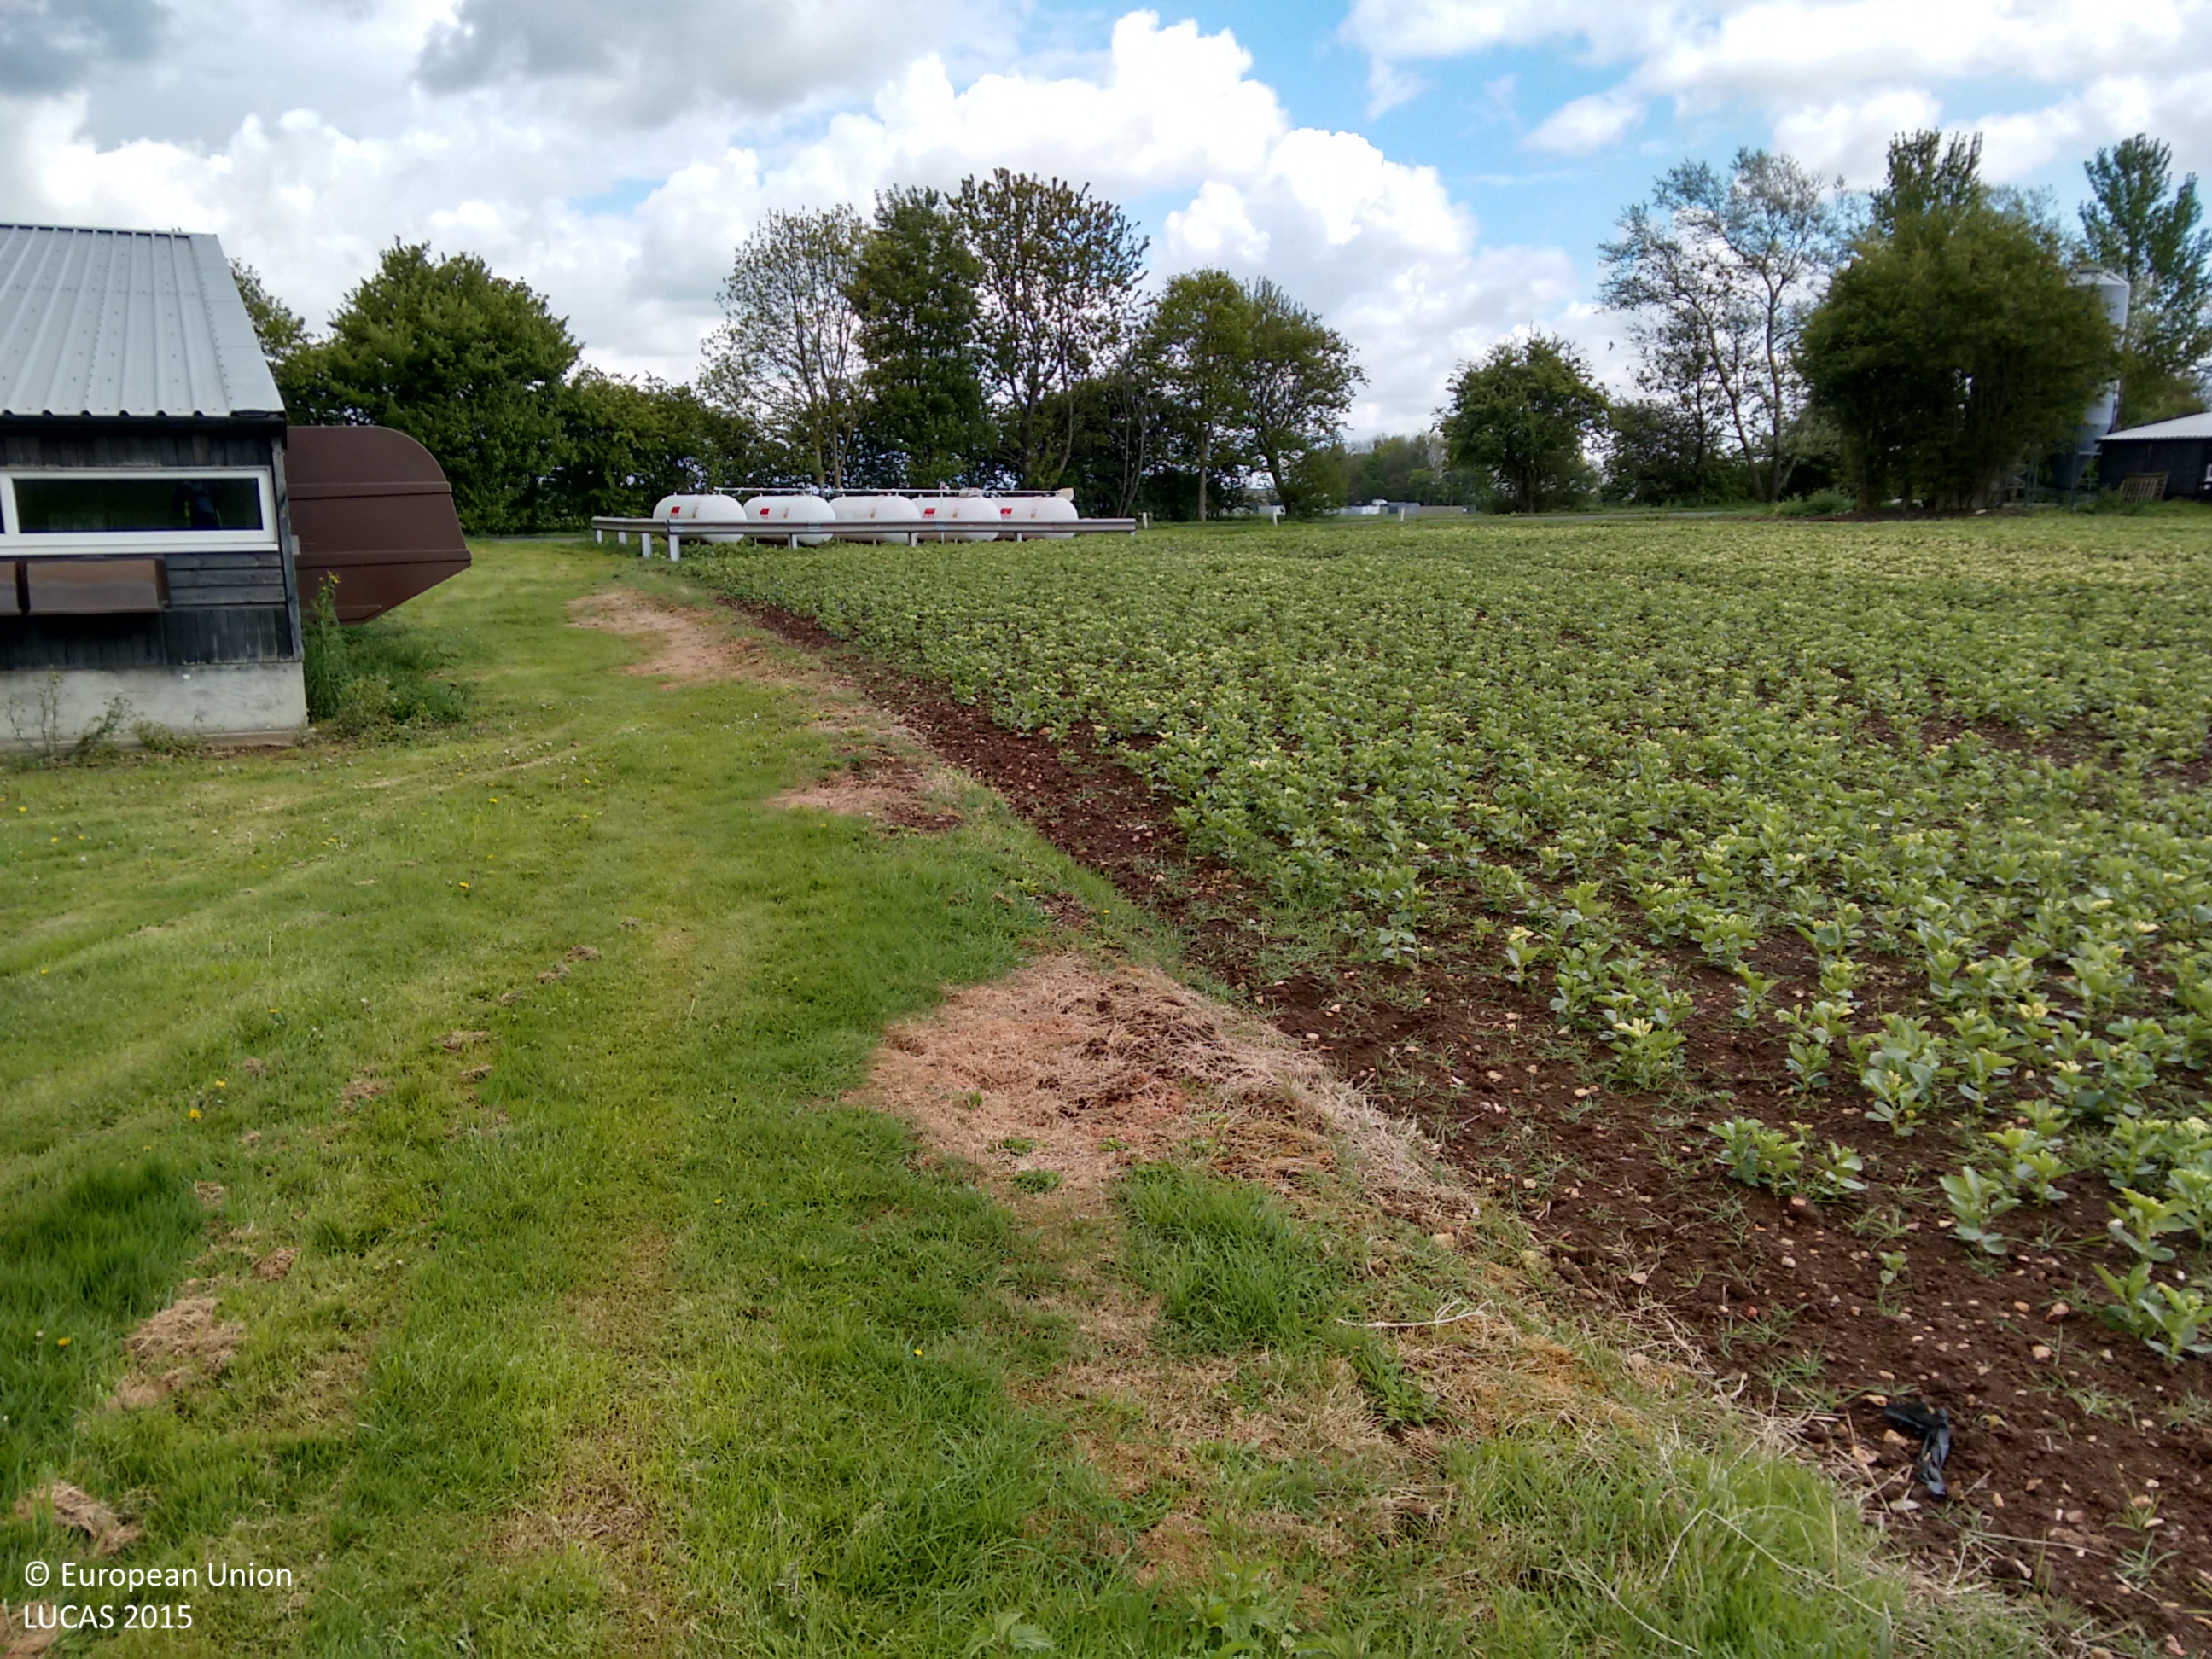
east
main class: Grassland
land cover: Grassland without tree/shrub cover
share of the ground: > 75 %
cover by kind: herbaceous plants 100 %
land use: Agriculture (excluding fallow land and kitchen gardens)
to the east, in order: Grassland without tree/shrub cover; Artificial constructions in urban areas; Grassland without tree/shrub cover; Paved roads, cycling and walking lanes; Grass margins; Managed hedges; Grass margins; Common wheat
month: May
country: GB
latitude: 53.3860
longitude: -0.2129
